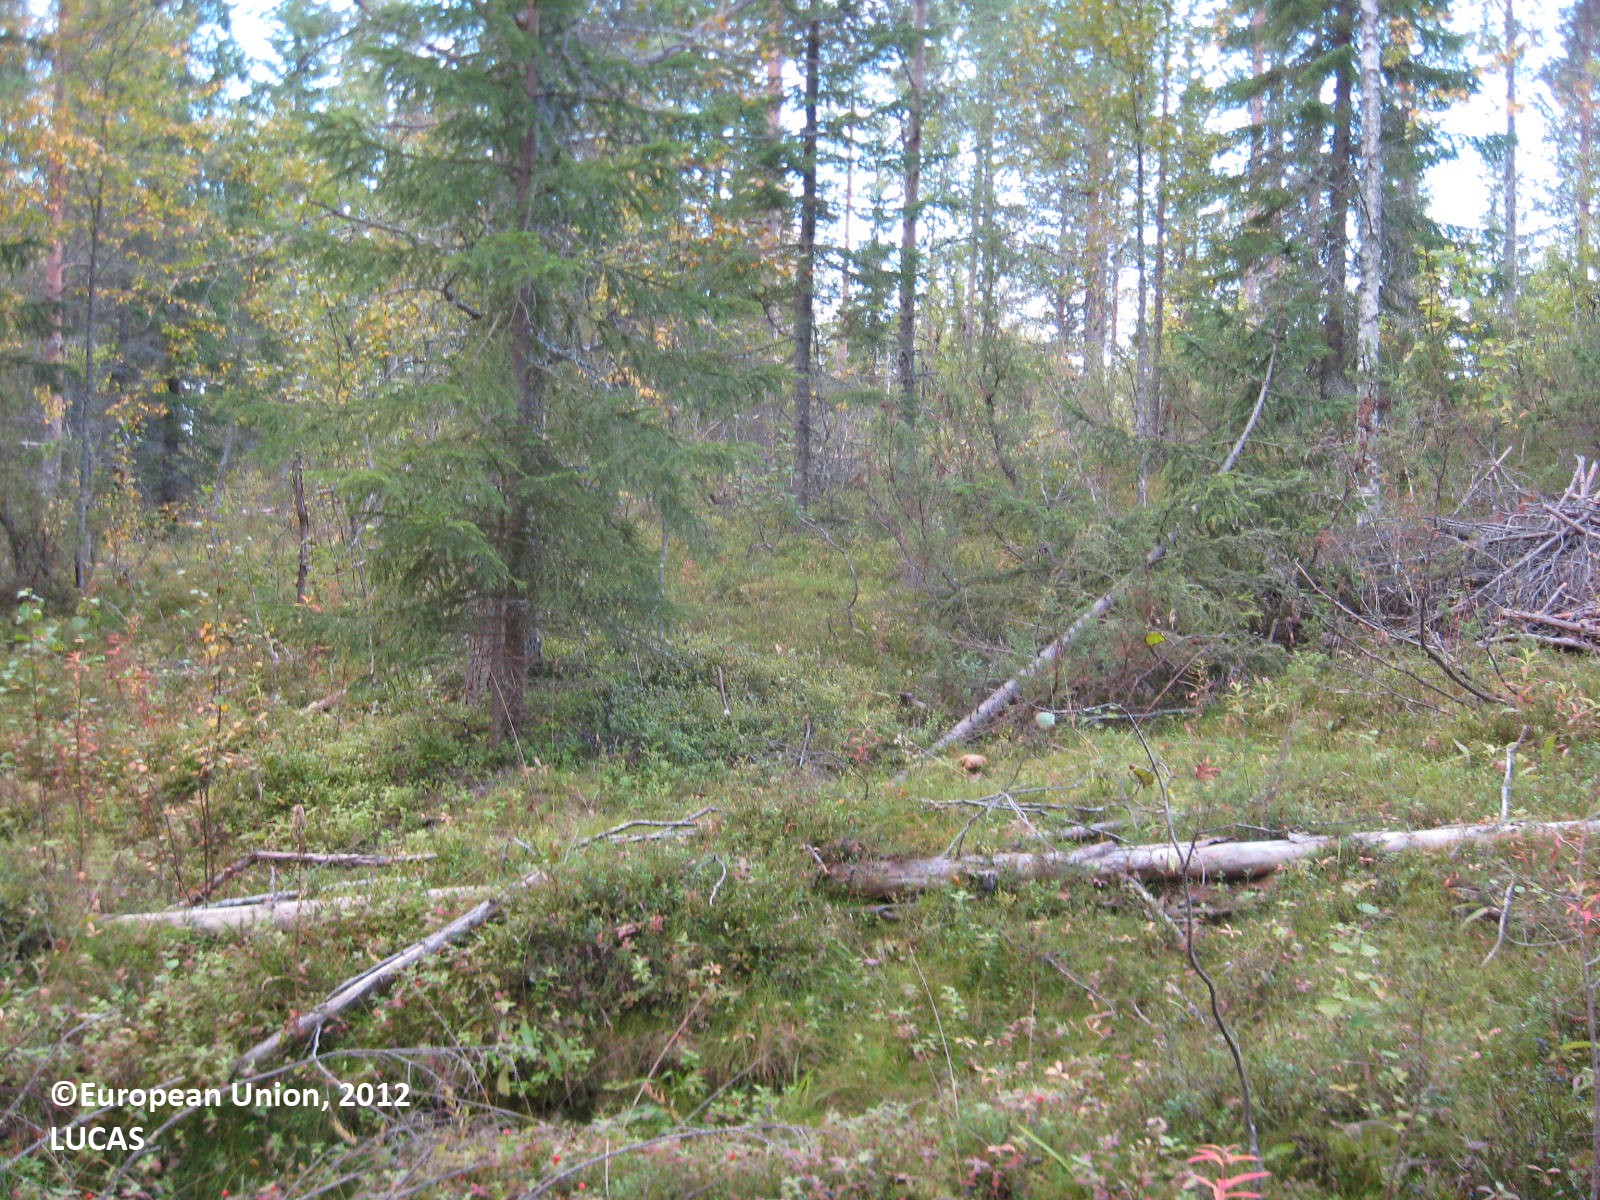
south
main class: Woodland
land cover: Other coniferous woodland
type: boreal forest
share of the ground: > 75 %
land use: Forestry
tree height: > 5 m
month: August
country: FI
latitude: 63.9477
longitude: 29.8472
